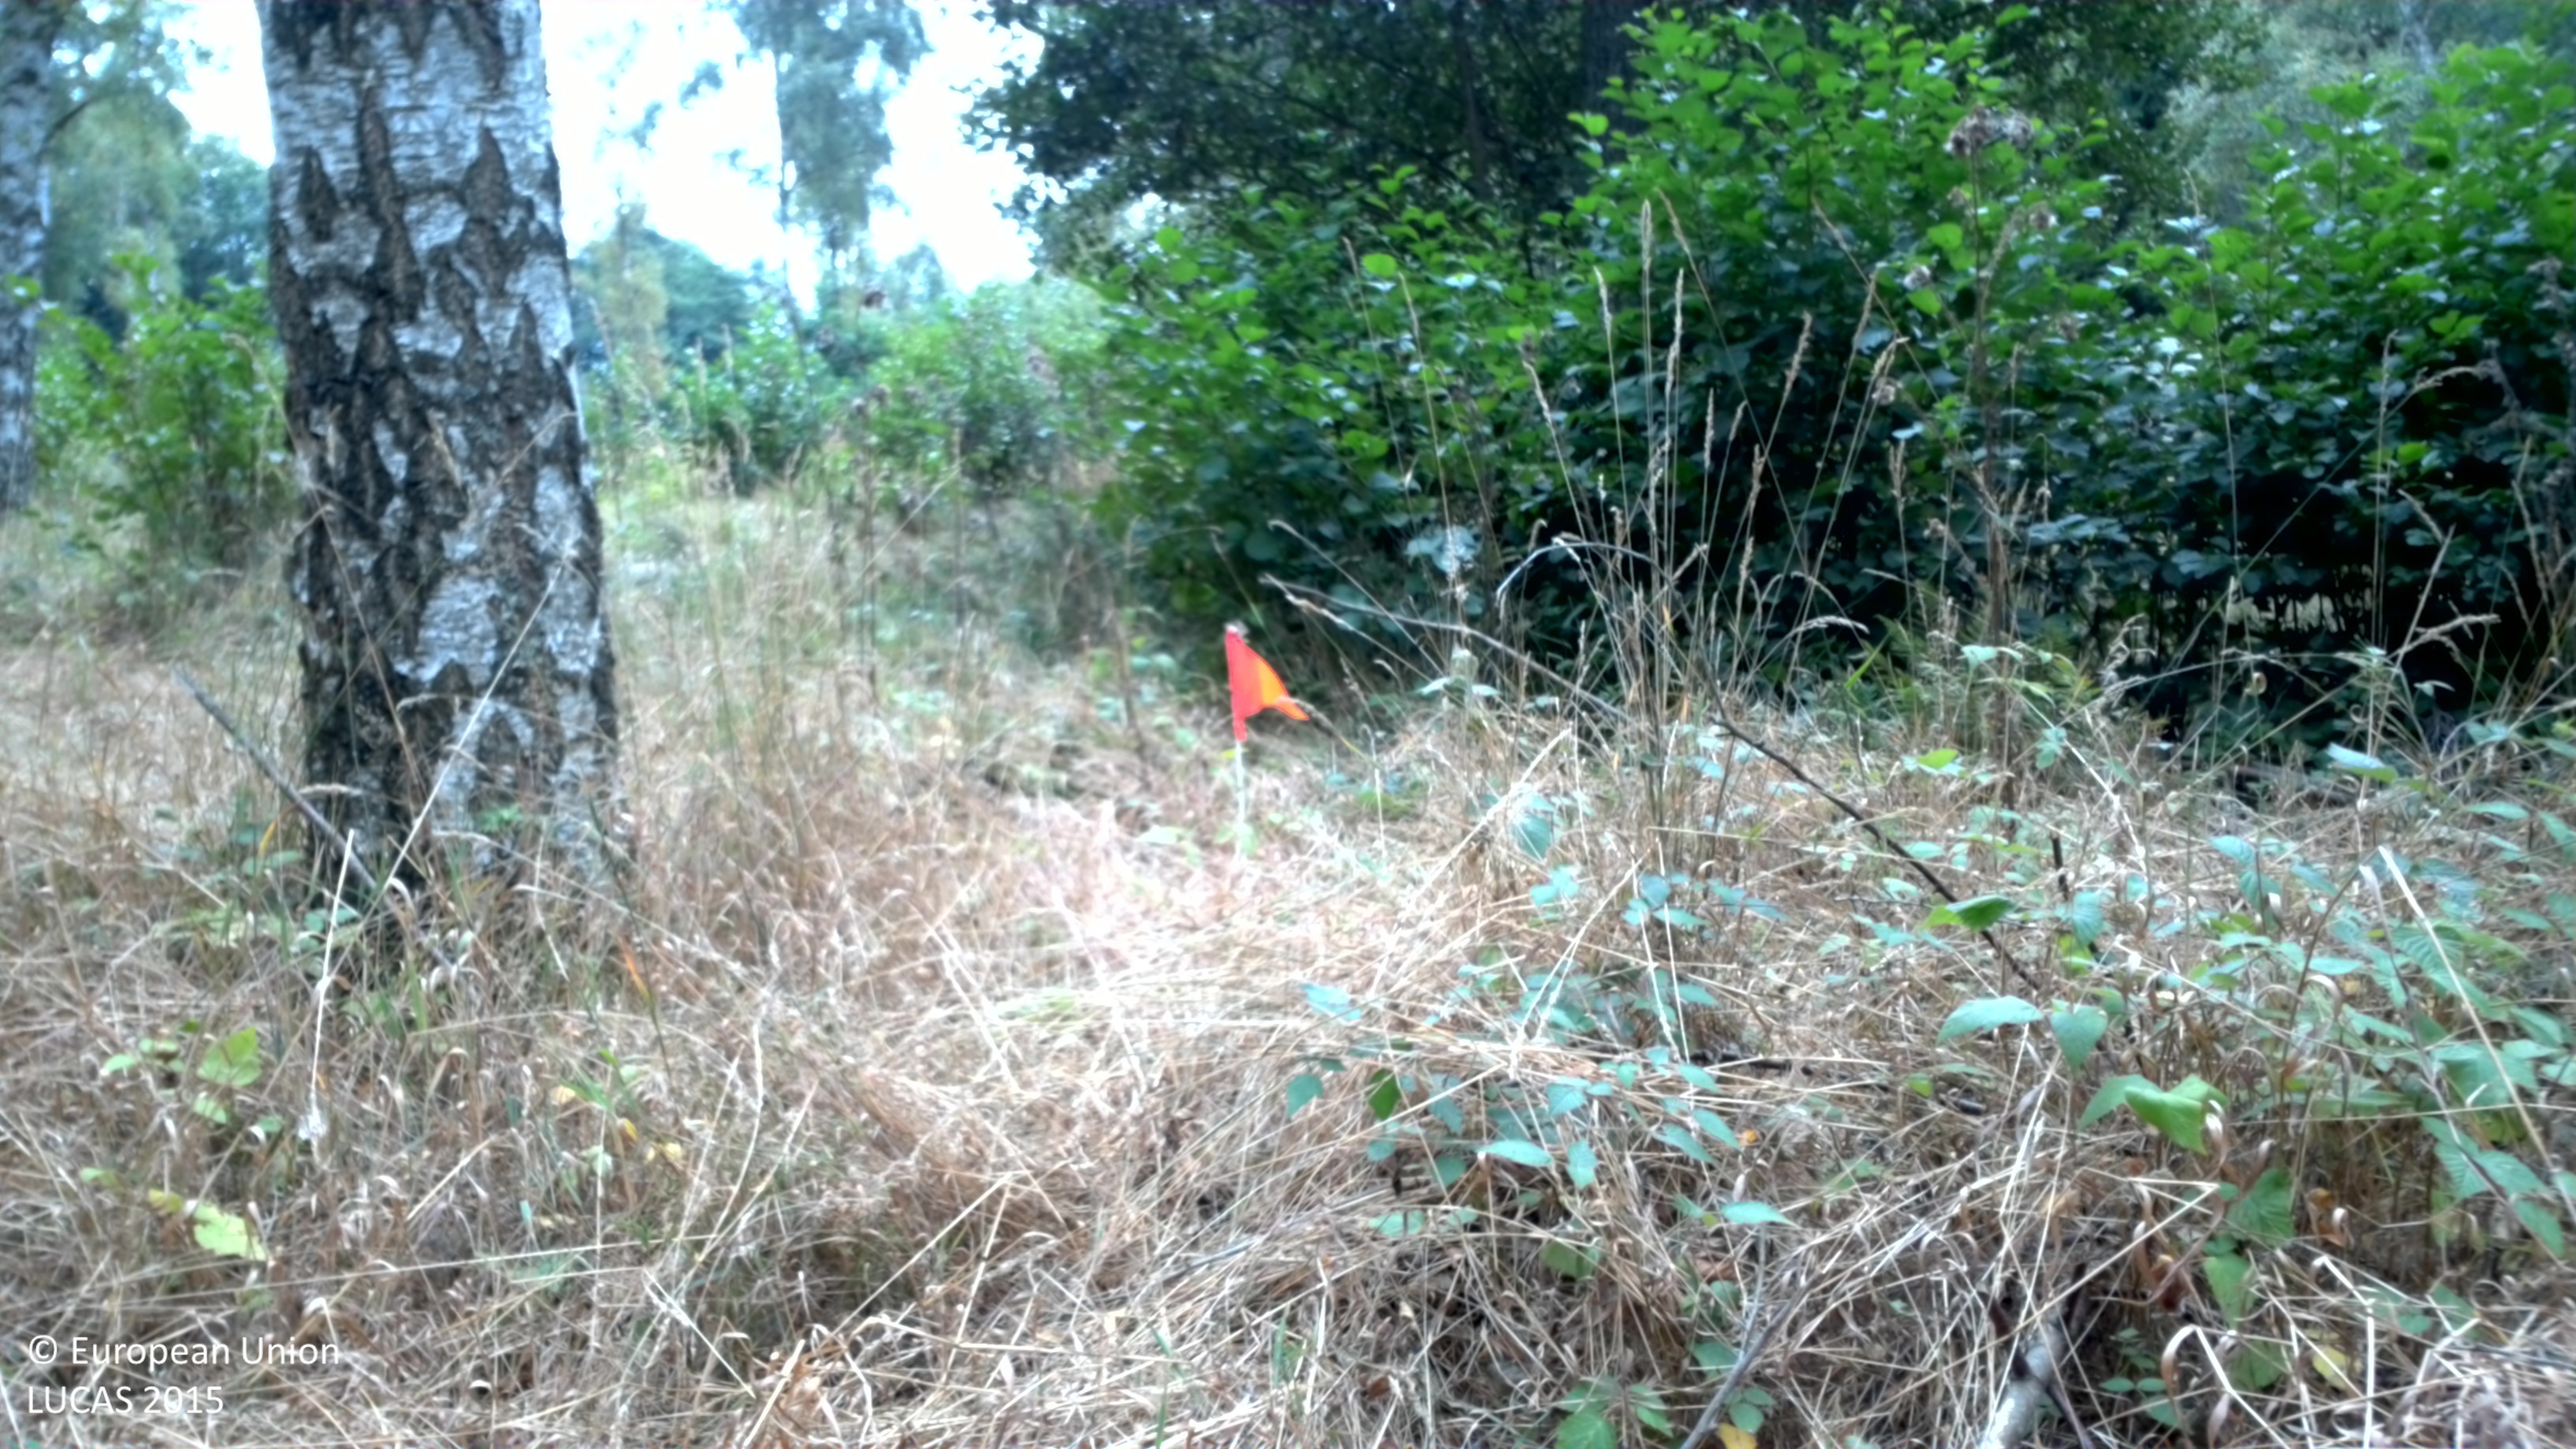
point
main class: Woodland
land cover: Broadleaved woodland
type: hemiboreal forest and nemoral coniferous forest and mixed broadleaved-coniferous forest
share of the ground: 10 - 25 %
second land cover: Grassland without tree/shrub cover
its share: > 75 %
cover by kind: herbaceous plants 60 %, broadleaved forest trees 25 %, shrubs 15 %
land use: Forestry
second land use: Agriculture (excluding fallow land and kitchen gardens)
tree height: > 5 m
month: August
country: SE
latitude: 56.1811
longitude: 15.4286
